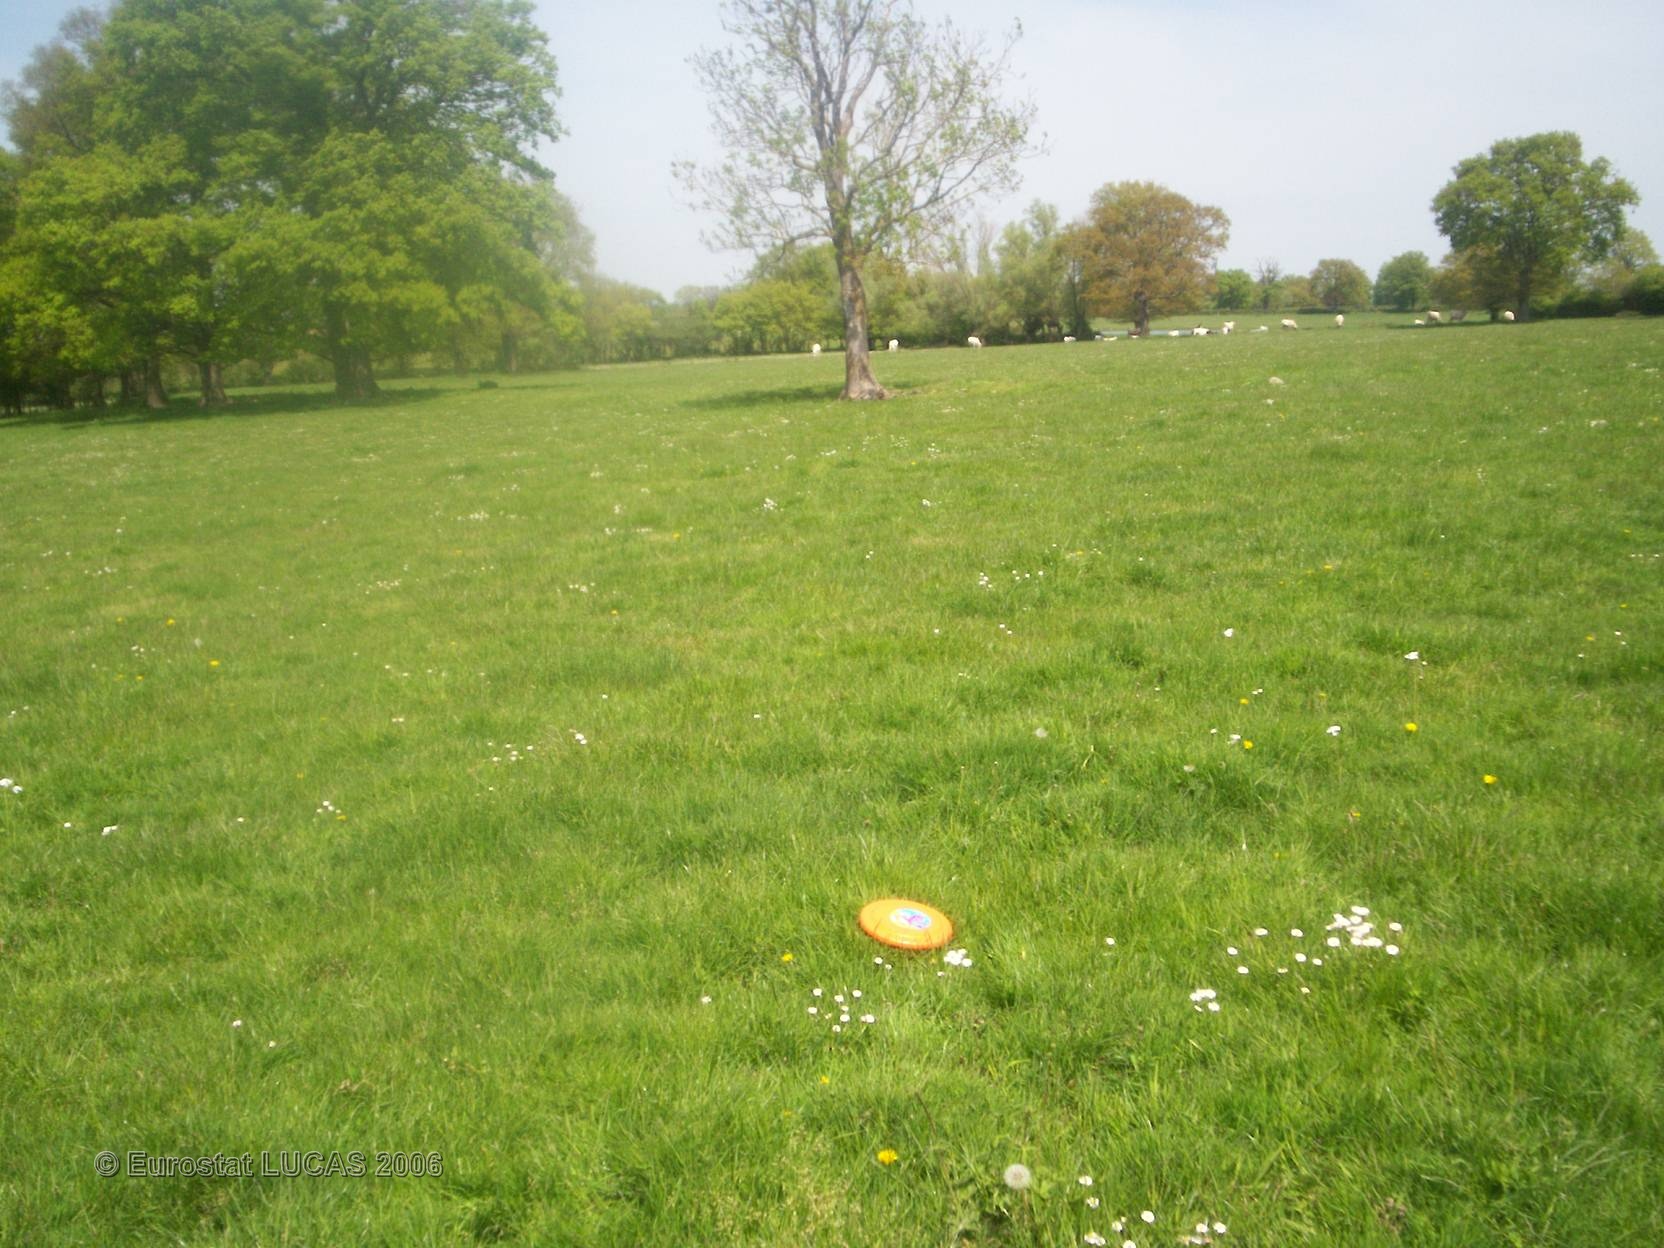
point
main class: Grassland
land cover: Grassland without tree/shrub cover
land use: Agriculture (excluding fallow land and kitchen gardens)
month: May
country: FR
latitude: 46.4935
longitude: 3.1577
